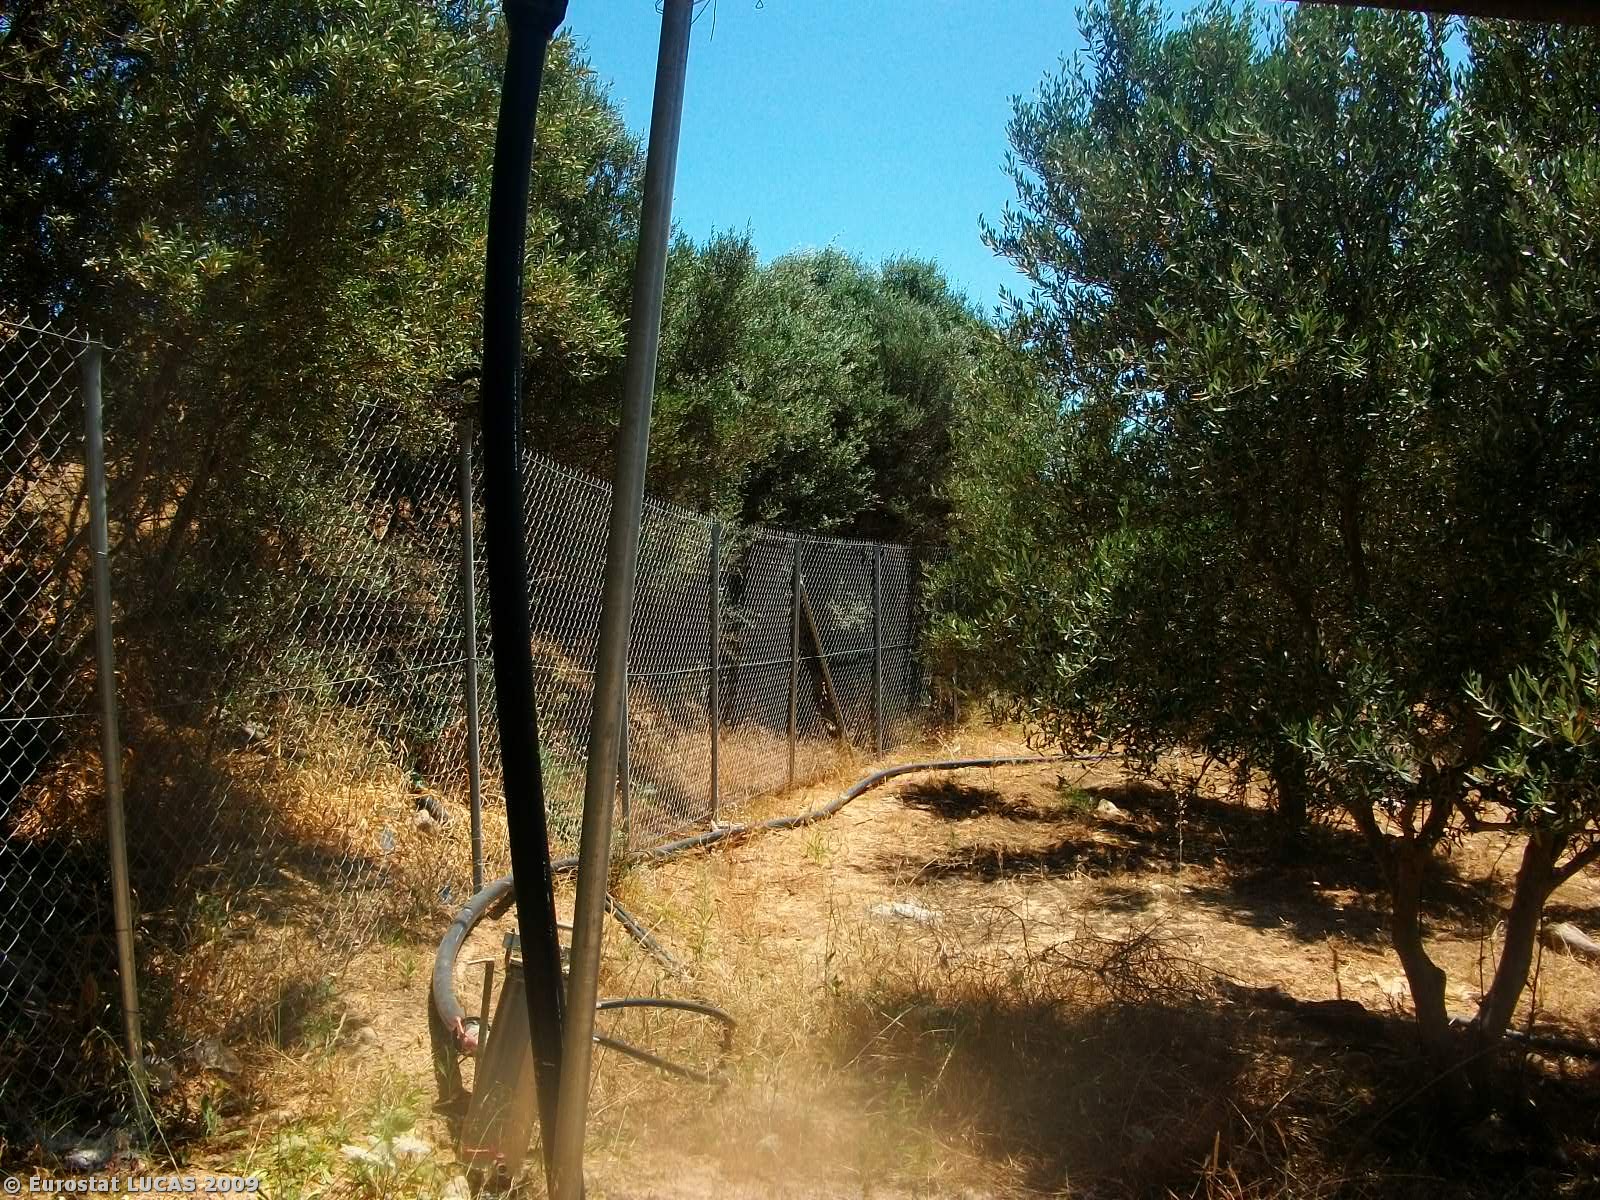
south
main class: Cropland
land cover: Olive groves
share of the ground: 50 - 75 %
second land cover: Bare land
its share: > 75 %
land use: Agriculture (excluding fallow land and kitchen gardens)
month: June
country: GR
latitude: 35.0473
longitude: 24.8393
